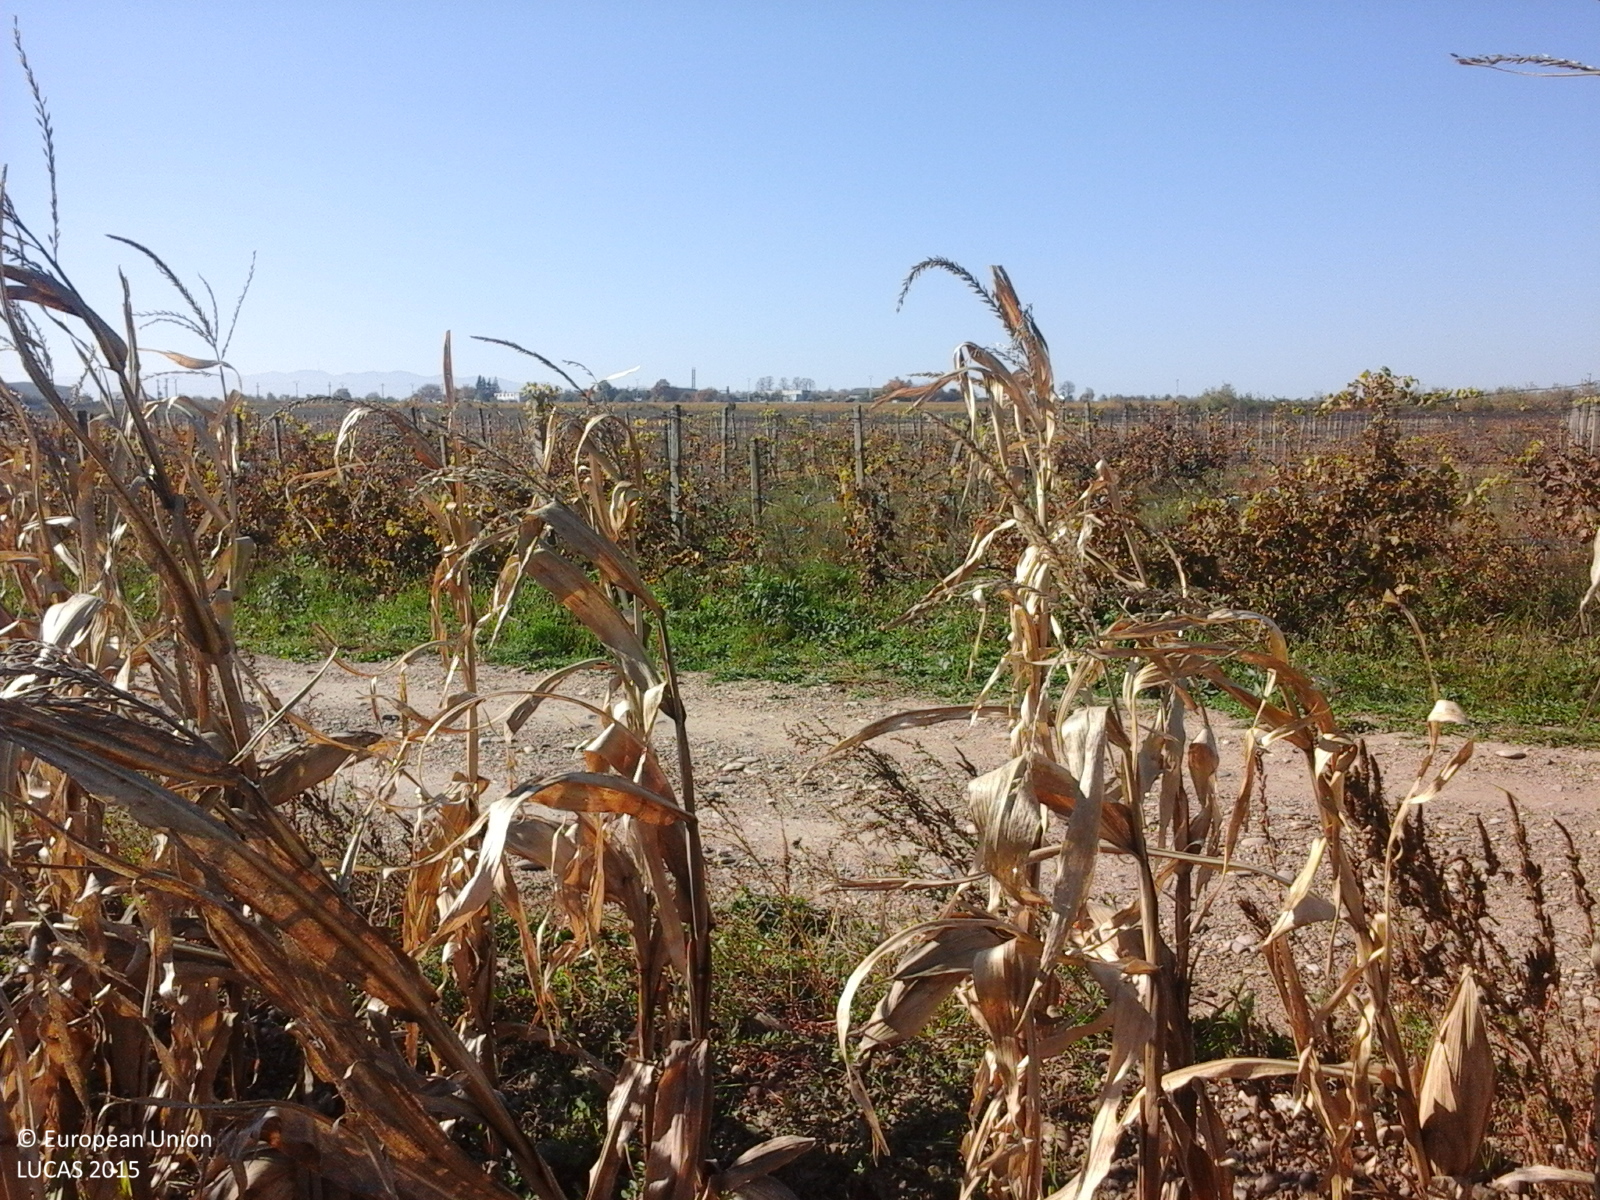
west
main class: Cropland
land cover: Maize
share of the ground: > 75 %
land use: Agriculture (excluding fallow land and kitchen gardens)
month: October
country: RO
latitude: 45.9134
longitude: 27.1257
